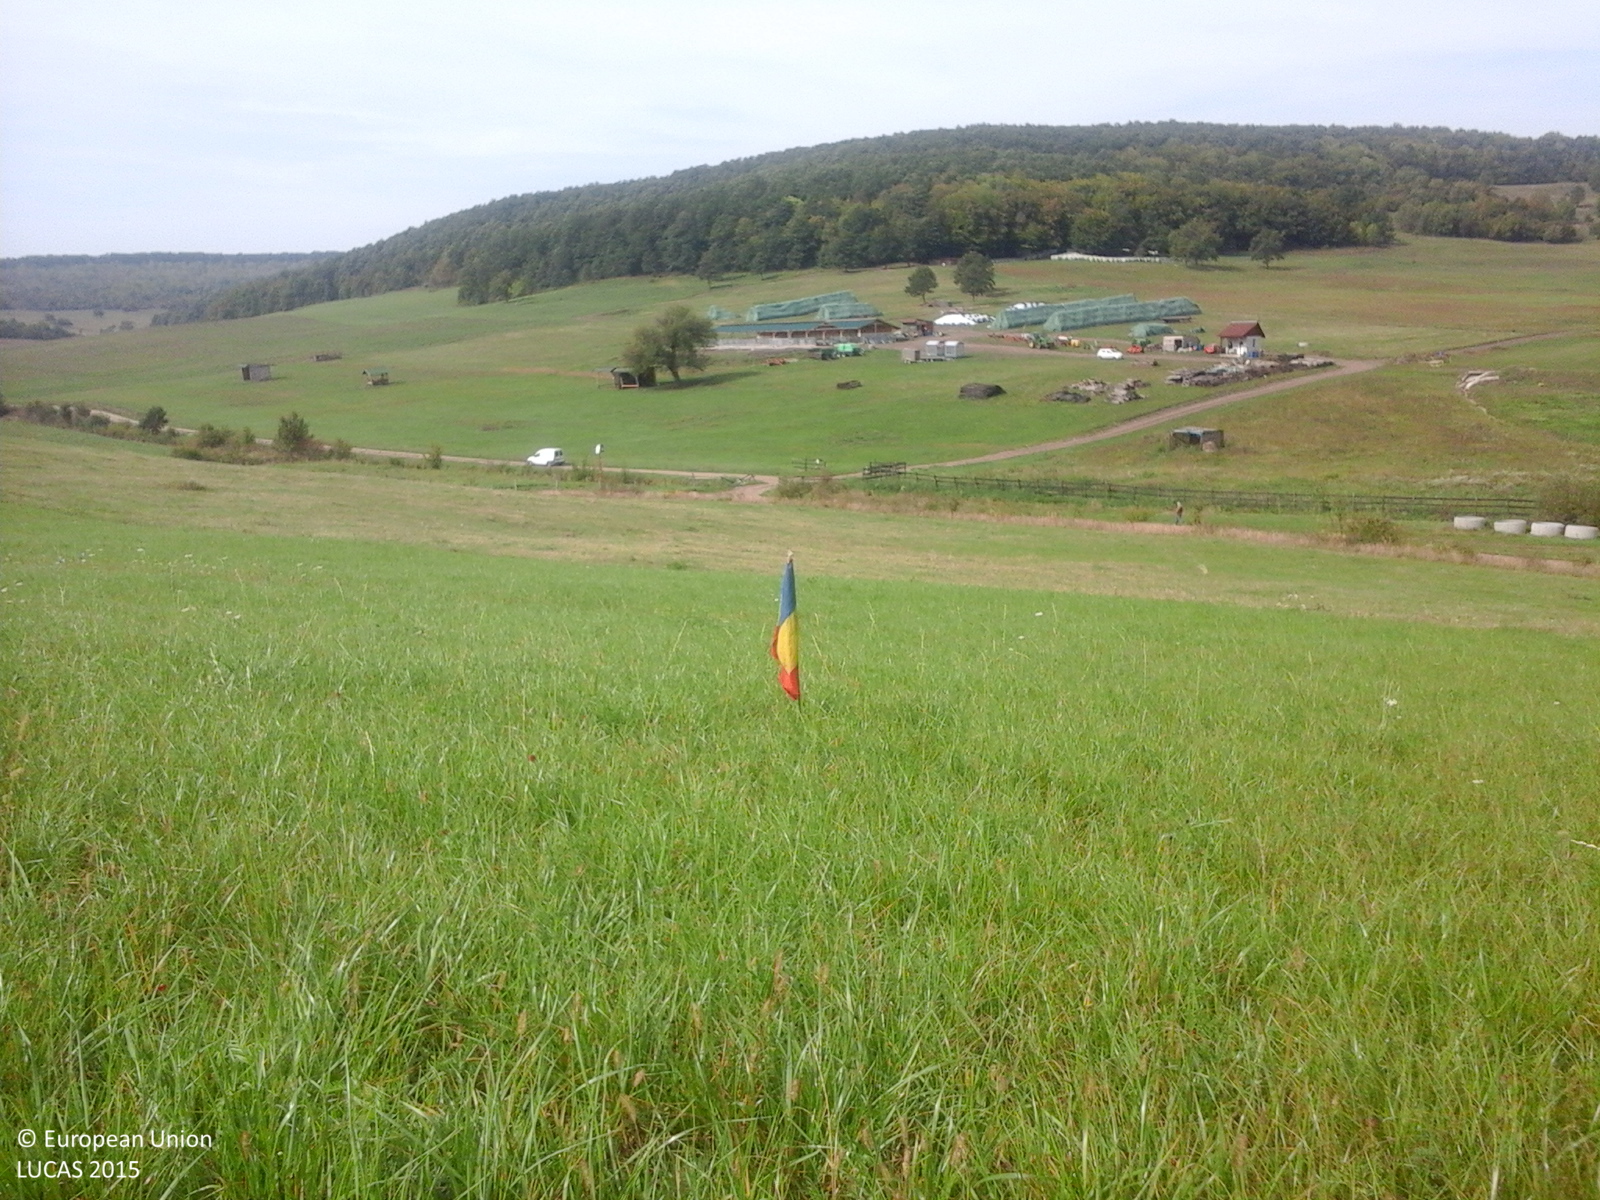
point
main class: Grassland
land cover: Grassland without tree/shrub cover
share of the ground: > 75 %
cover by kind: herbaceous plants 100 %
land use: Agriculture (excluding fallow land and kitchen gardens)
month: September
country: RO
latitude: 46.9589
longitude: 23.4339
